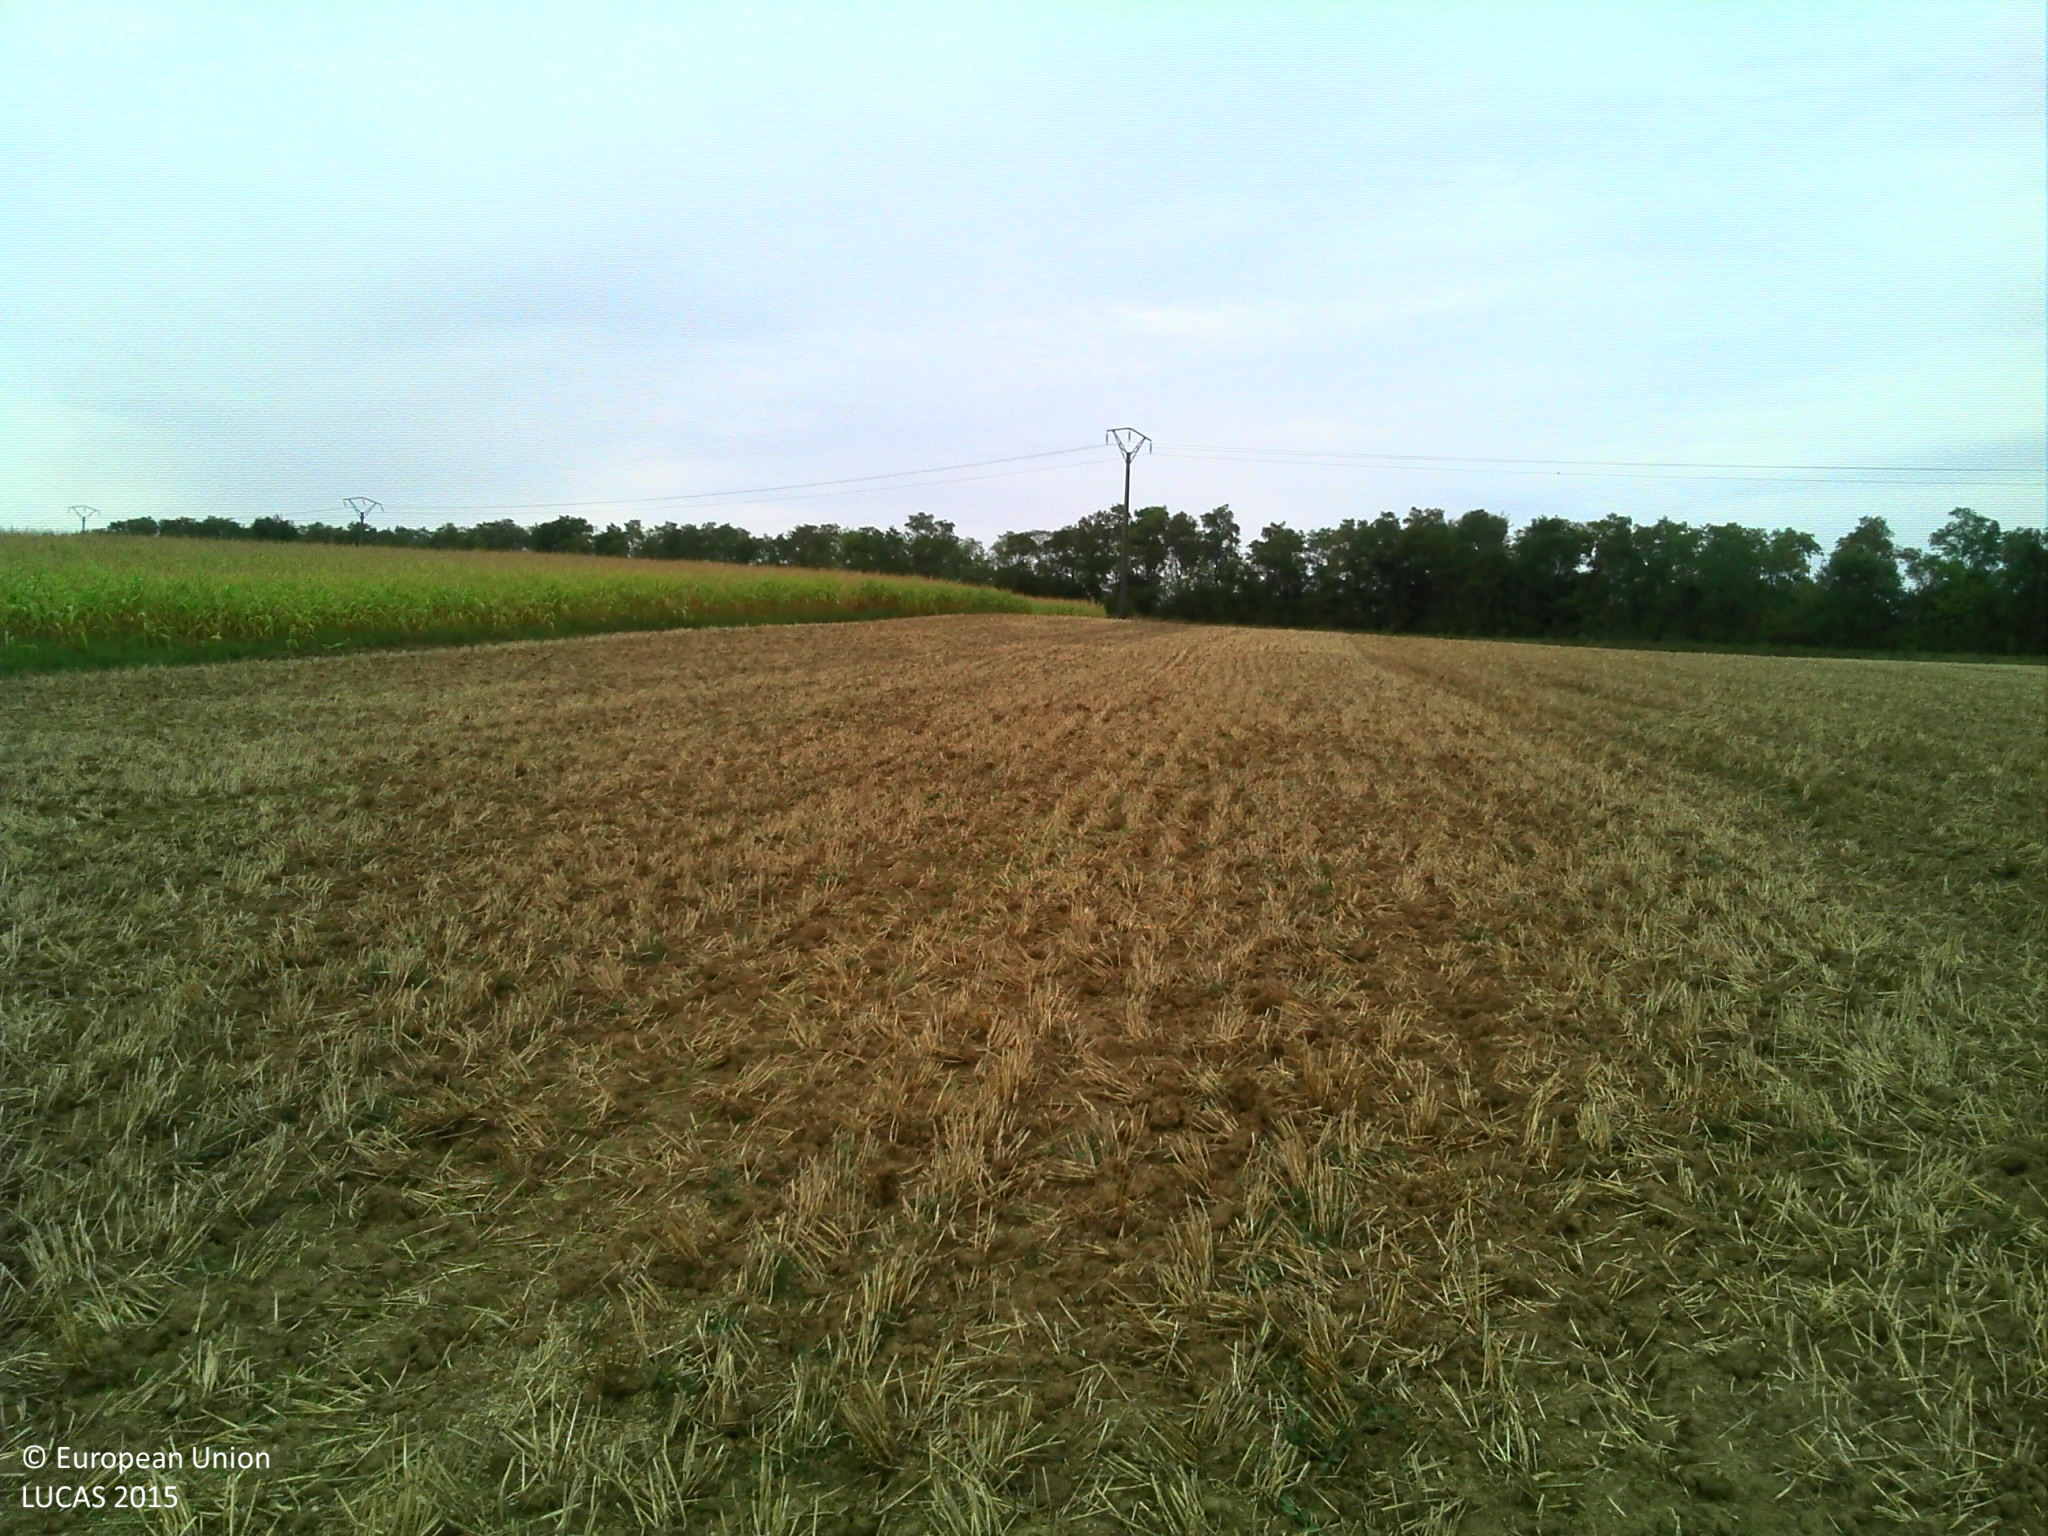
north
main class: Cropland
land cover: Common wheat
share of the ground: 10 - 25 %
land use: Agriculture (excluding fallow land and kitchen gardens)
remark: Harvested field
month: August
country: FR
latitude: 48.9363
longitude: 7.6390
